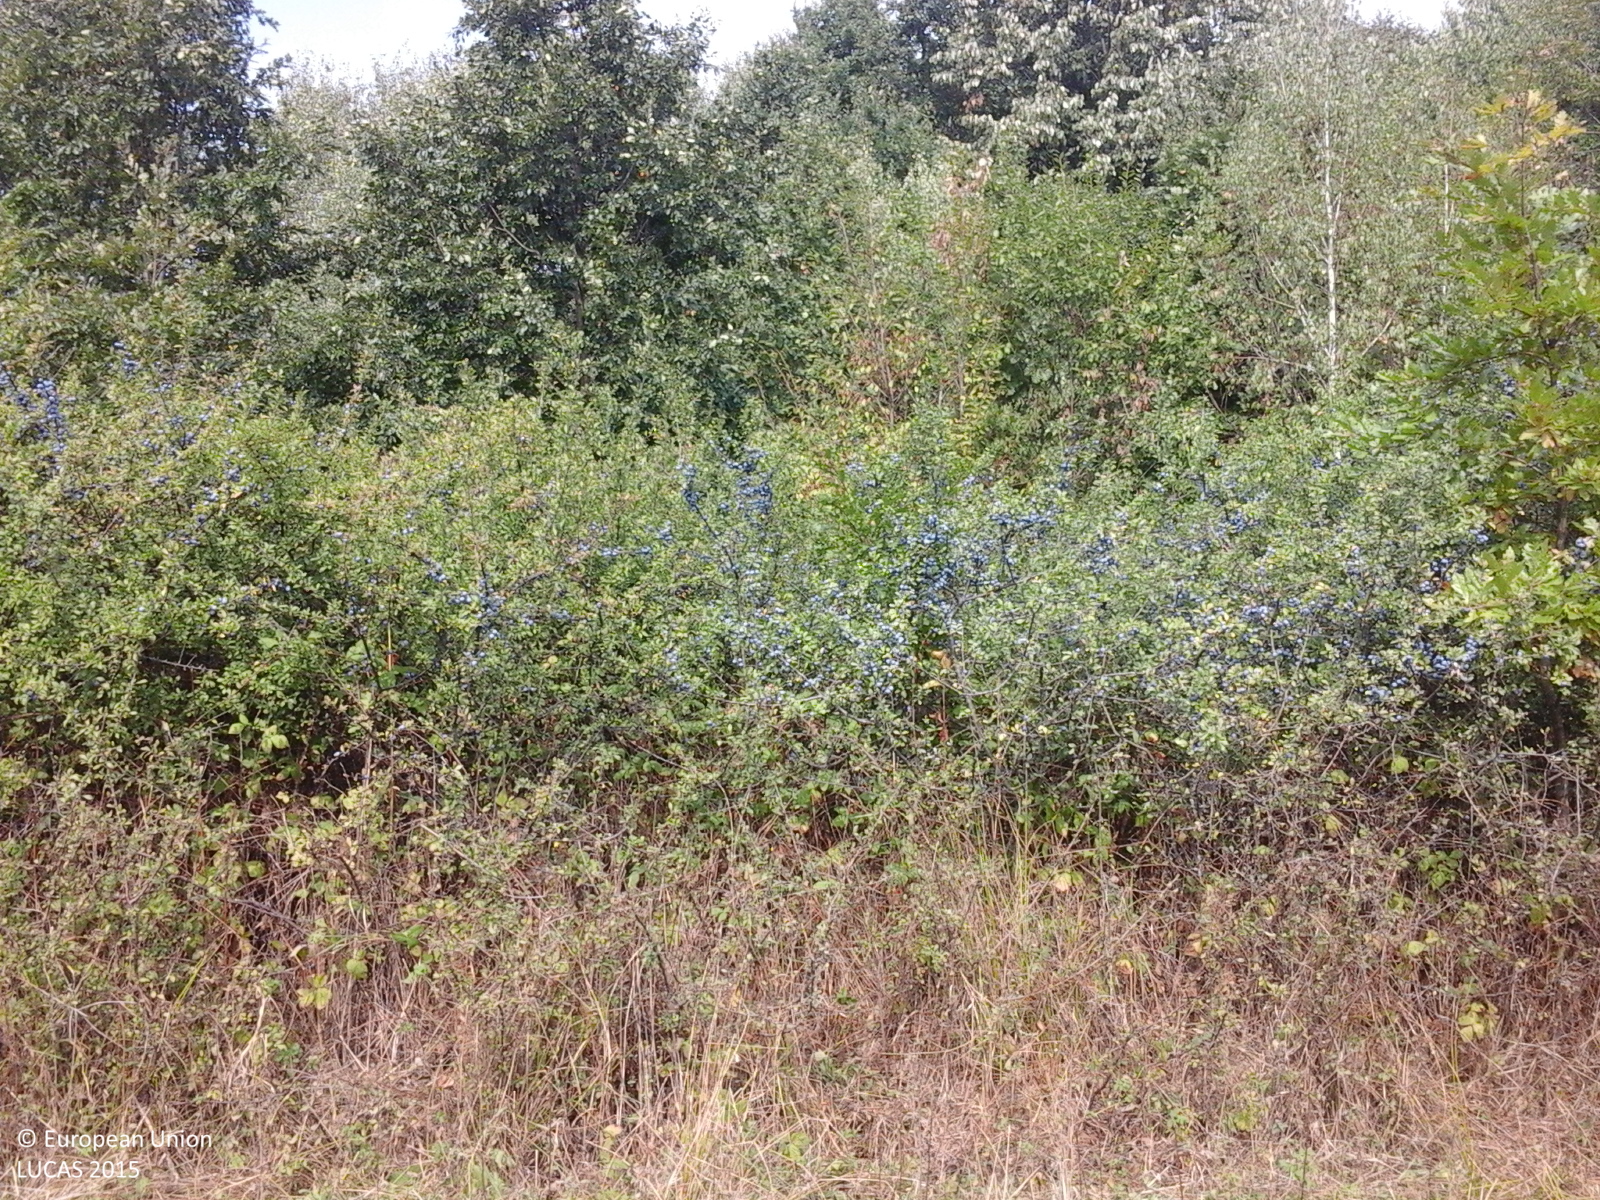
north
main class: Grassland
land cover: Grassland without tree/shrub cover
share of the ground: > 75 %
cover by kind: herbaceous plants 100 %
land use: Agriculture (excluding fallow land and kitchen gardens)
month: September
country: RO
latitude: 45.5203
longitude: 22.0607
